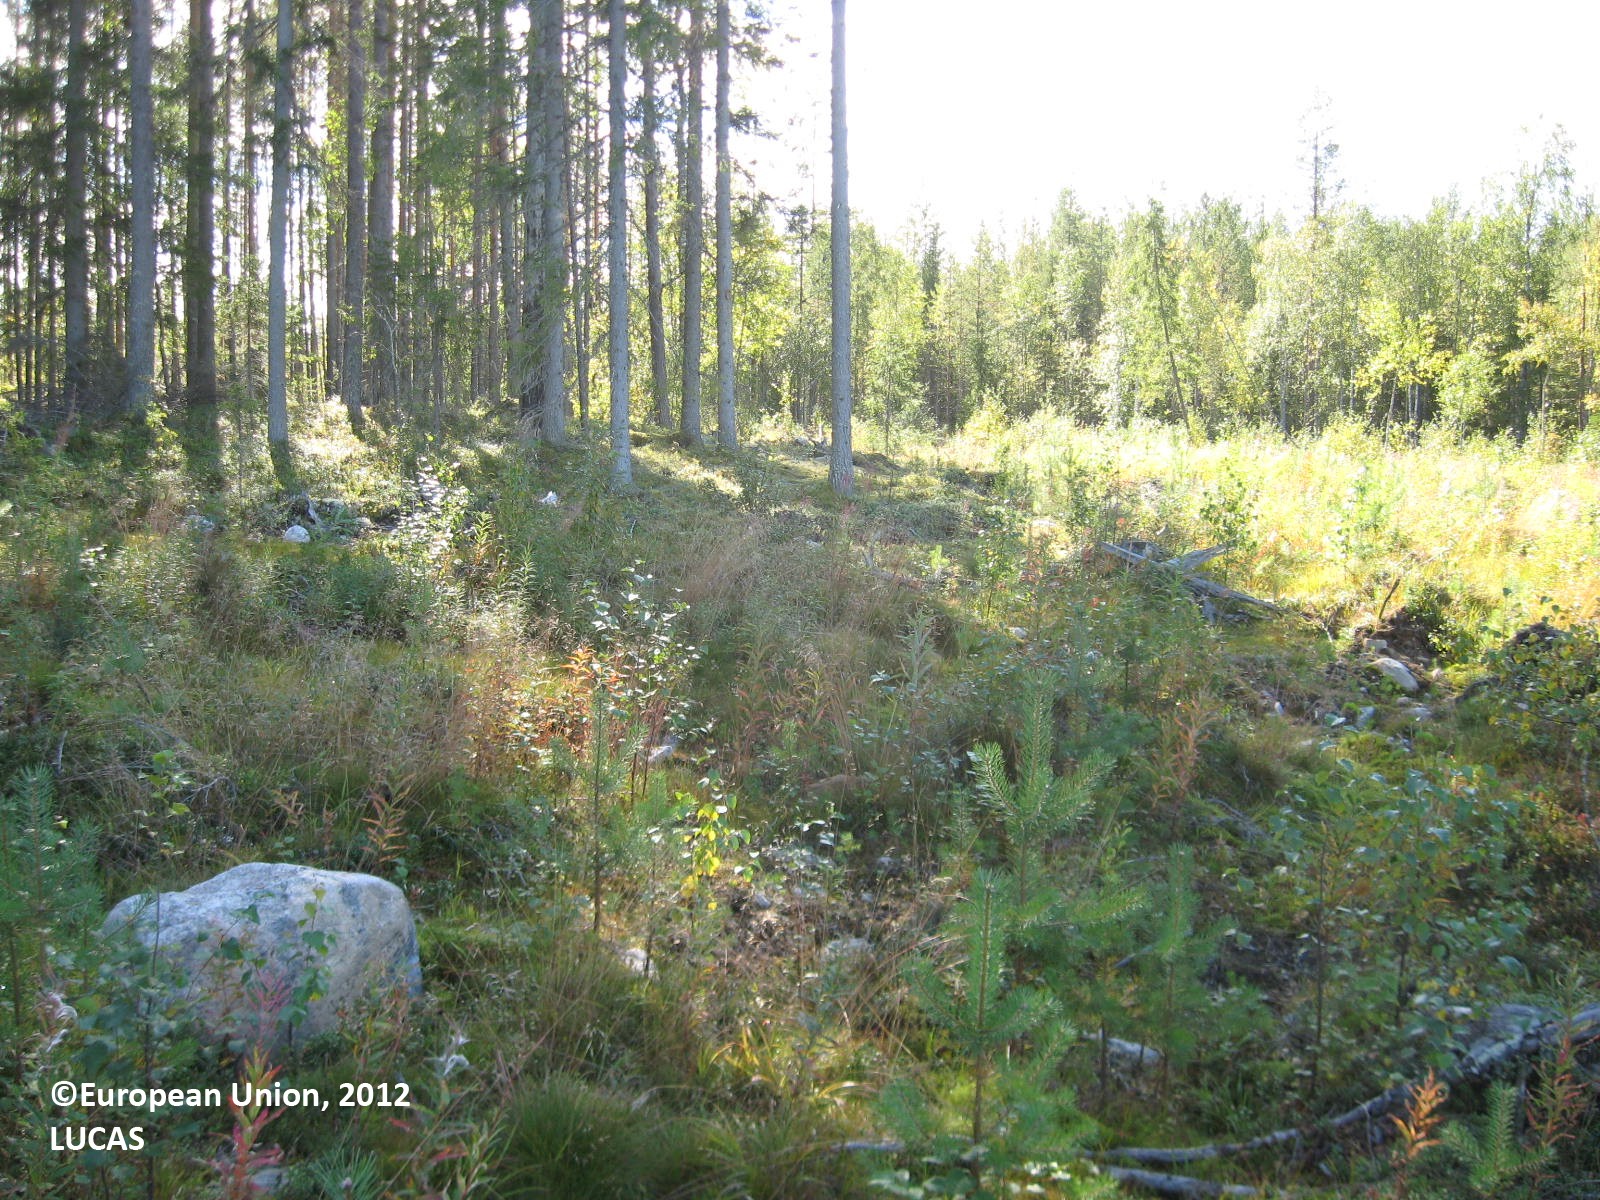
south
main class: Woodland
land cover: Other mixed woodland
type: boreal forest
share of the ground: 50 - 75 %
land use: Forestry
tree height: < 5 m
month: August
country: FI
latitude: 63.8345
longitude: 29.8514
